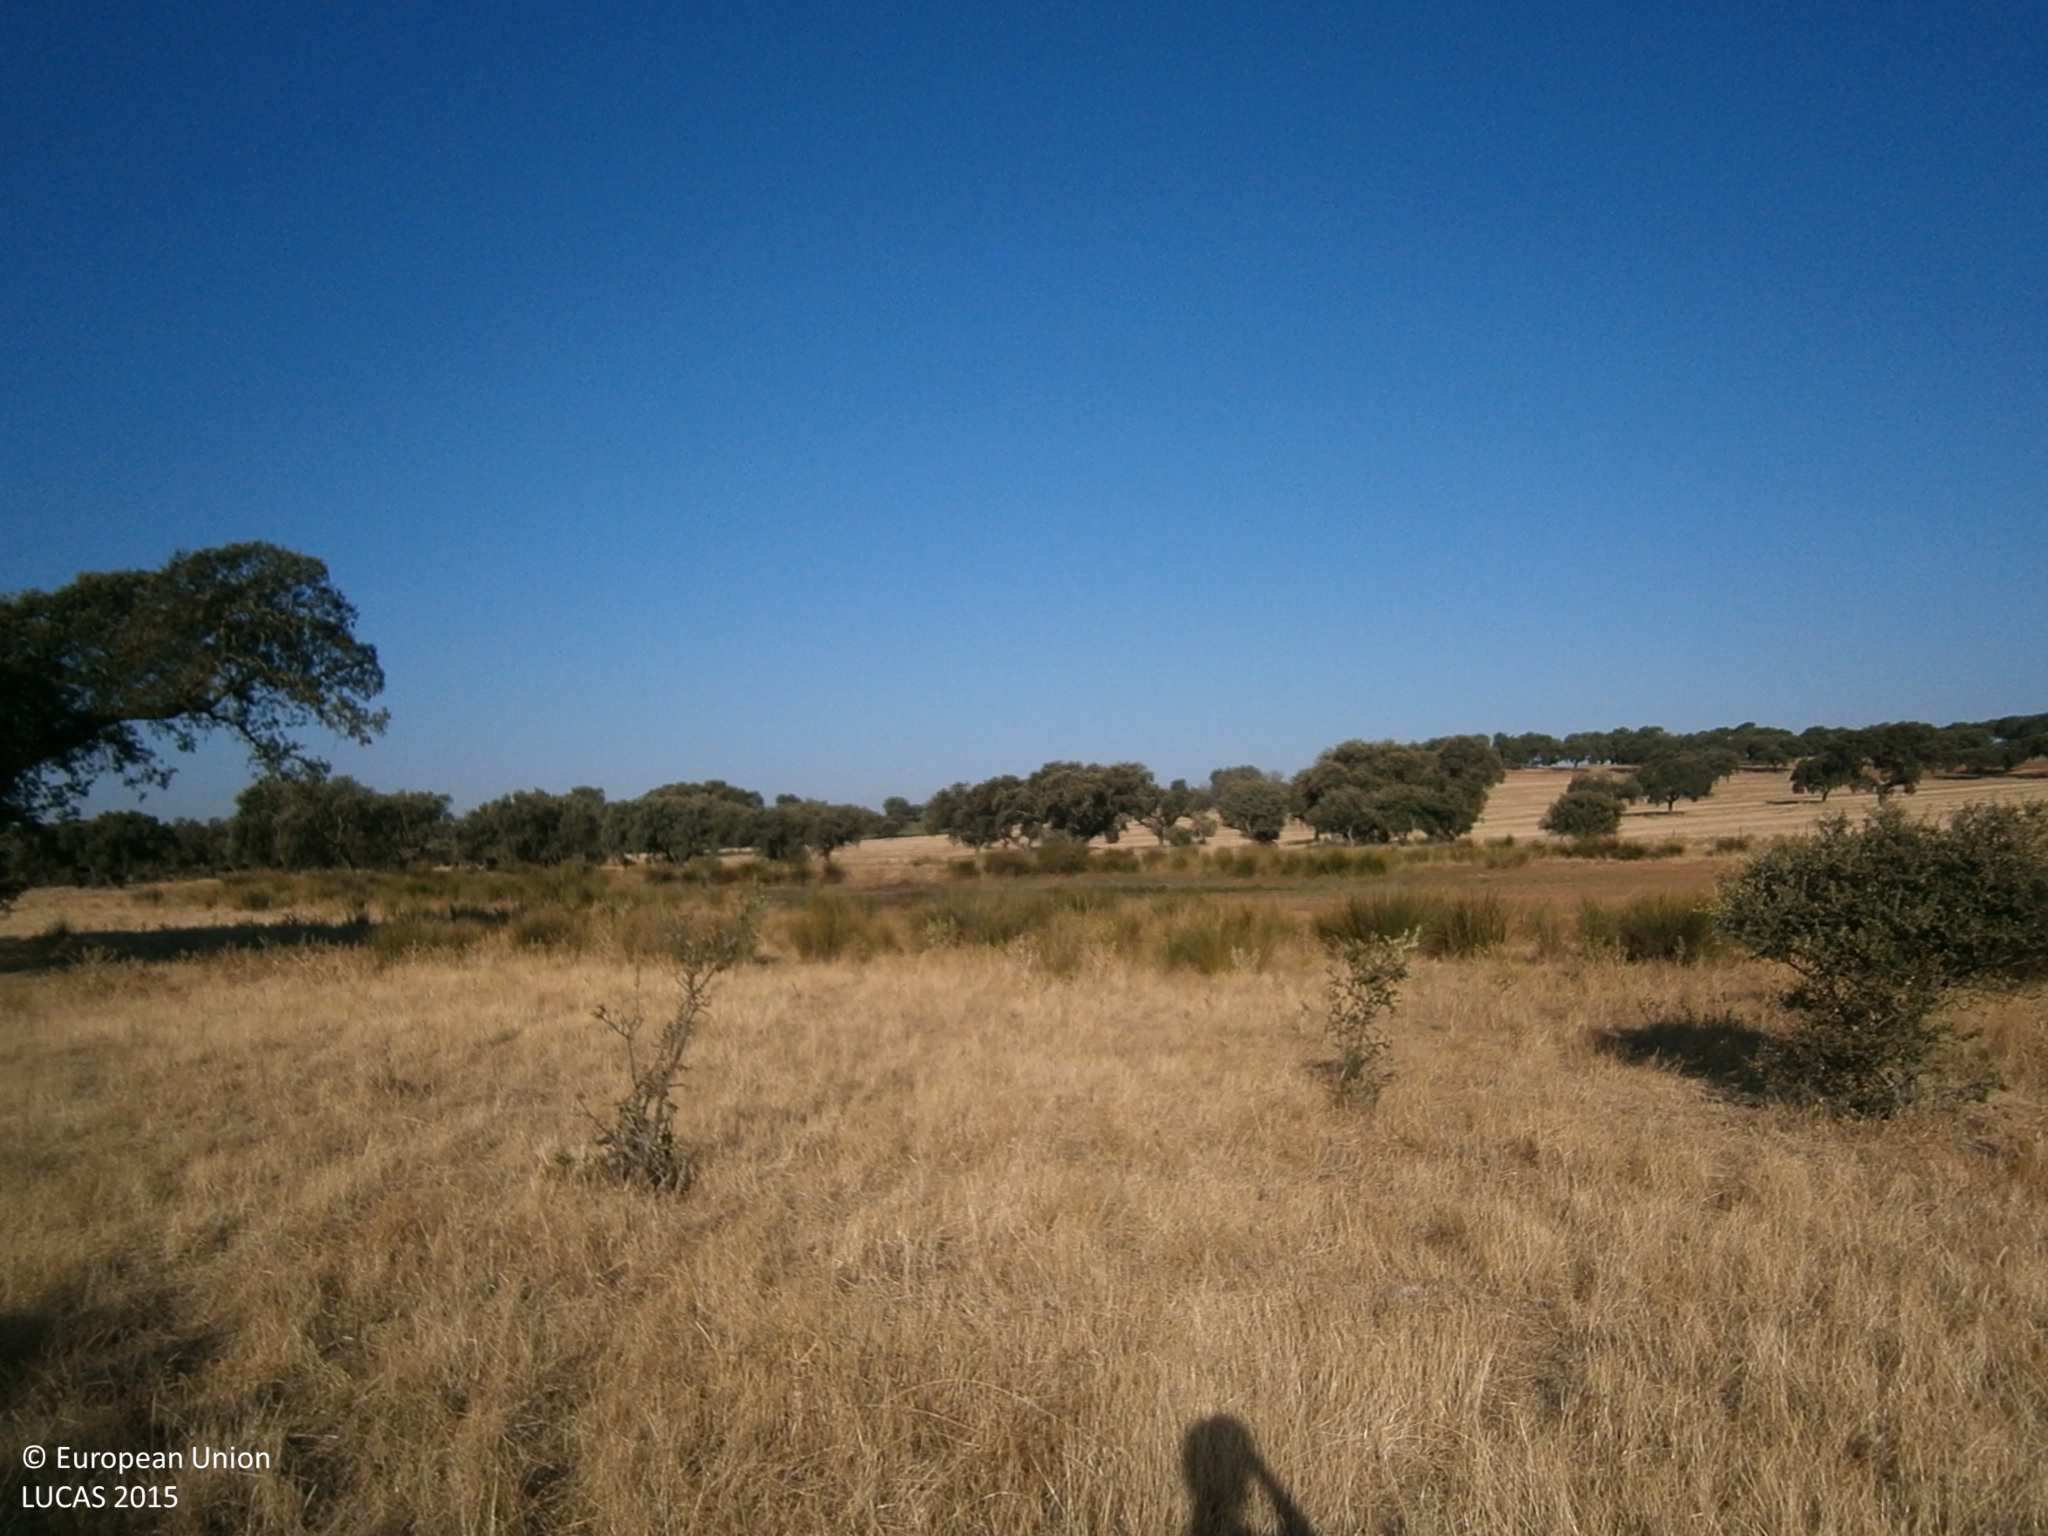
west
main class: Woodland
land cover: Broadleaved woodland
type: broadleaved evergreen forest
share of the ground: > 75 %
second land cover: Spontaneously vegetated surfaces
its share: > 75 %
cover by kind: broadleaved forest trees 90 %, shrubs 5 %
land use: Forestry
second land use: Agriculture (excluding fallow land and kitchen gardens)
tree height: > 5 m
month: July
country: ES
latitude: 38.9684
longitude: -6.7207
